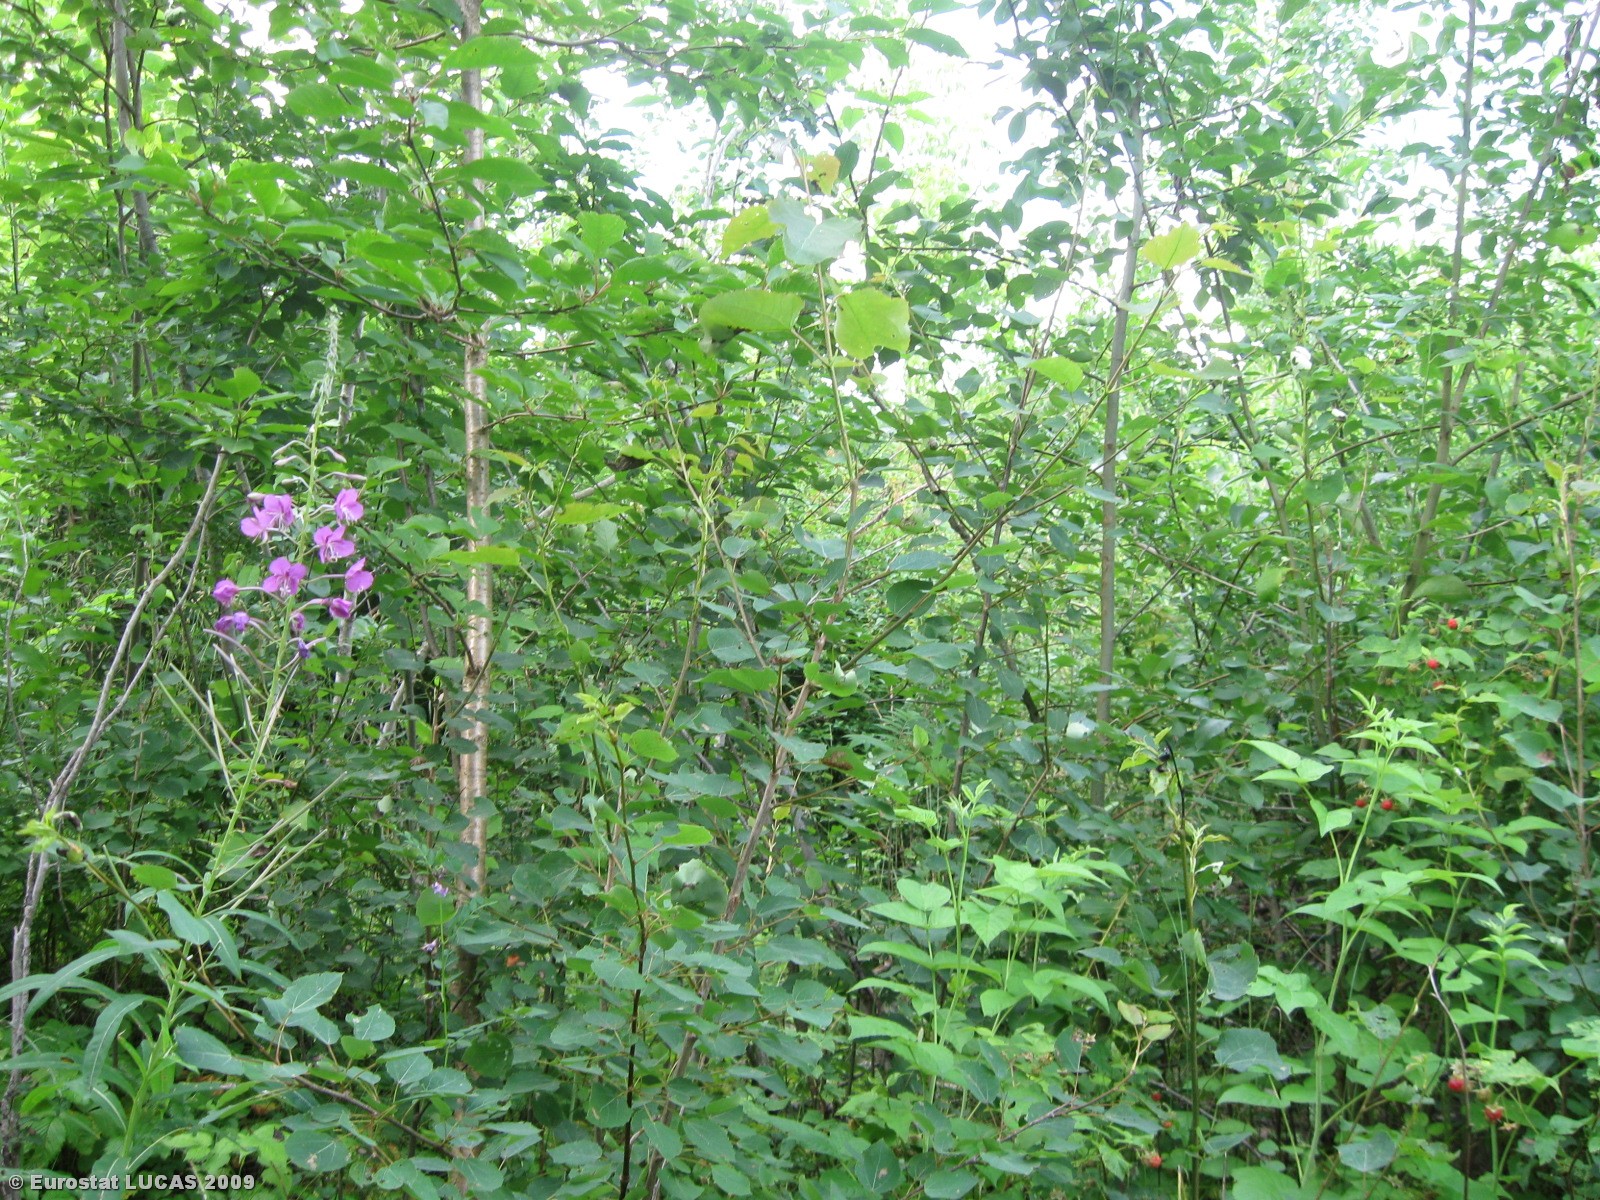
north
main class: Woodland
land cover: Broadleaved woodland
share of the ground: > 75 %
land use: Waste treatment
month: July
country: LT
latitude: 54.6461
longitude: 25.3884
